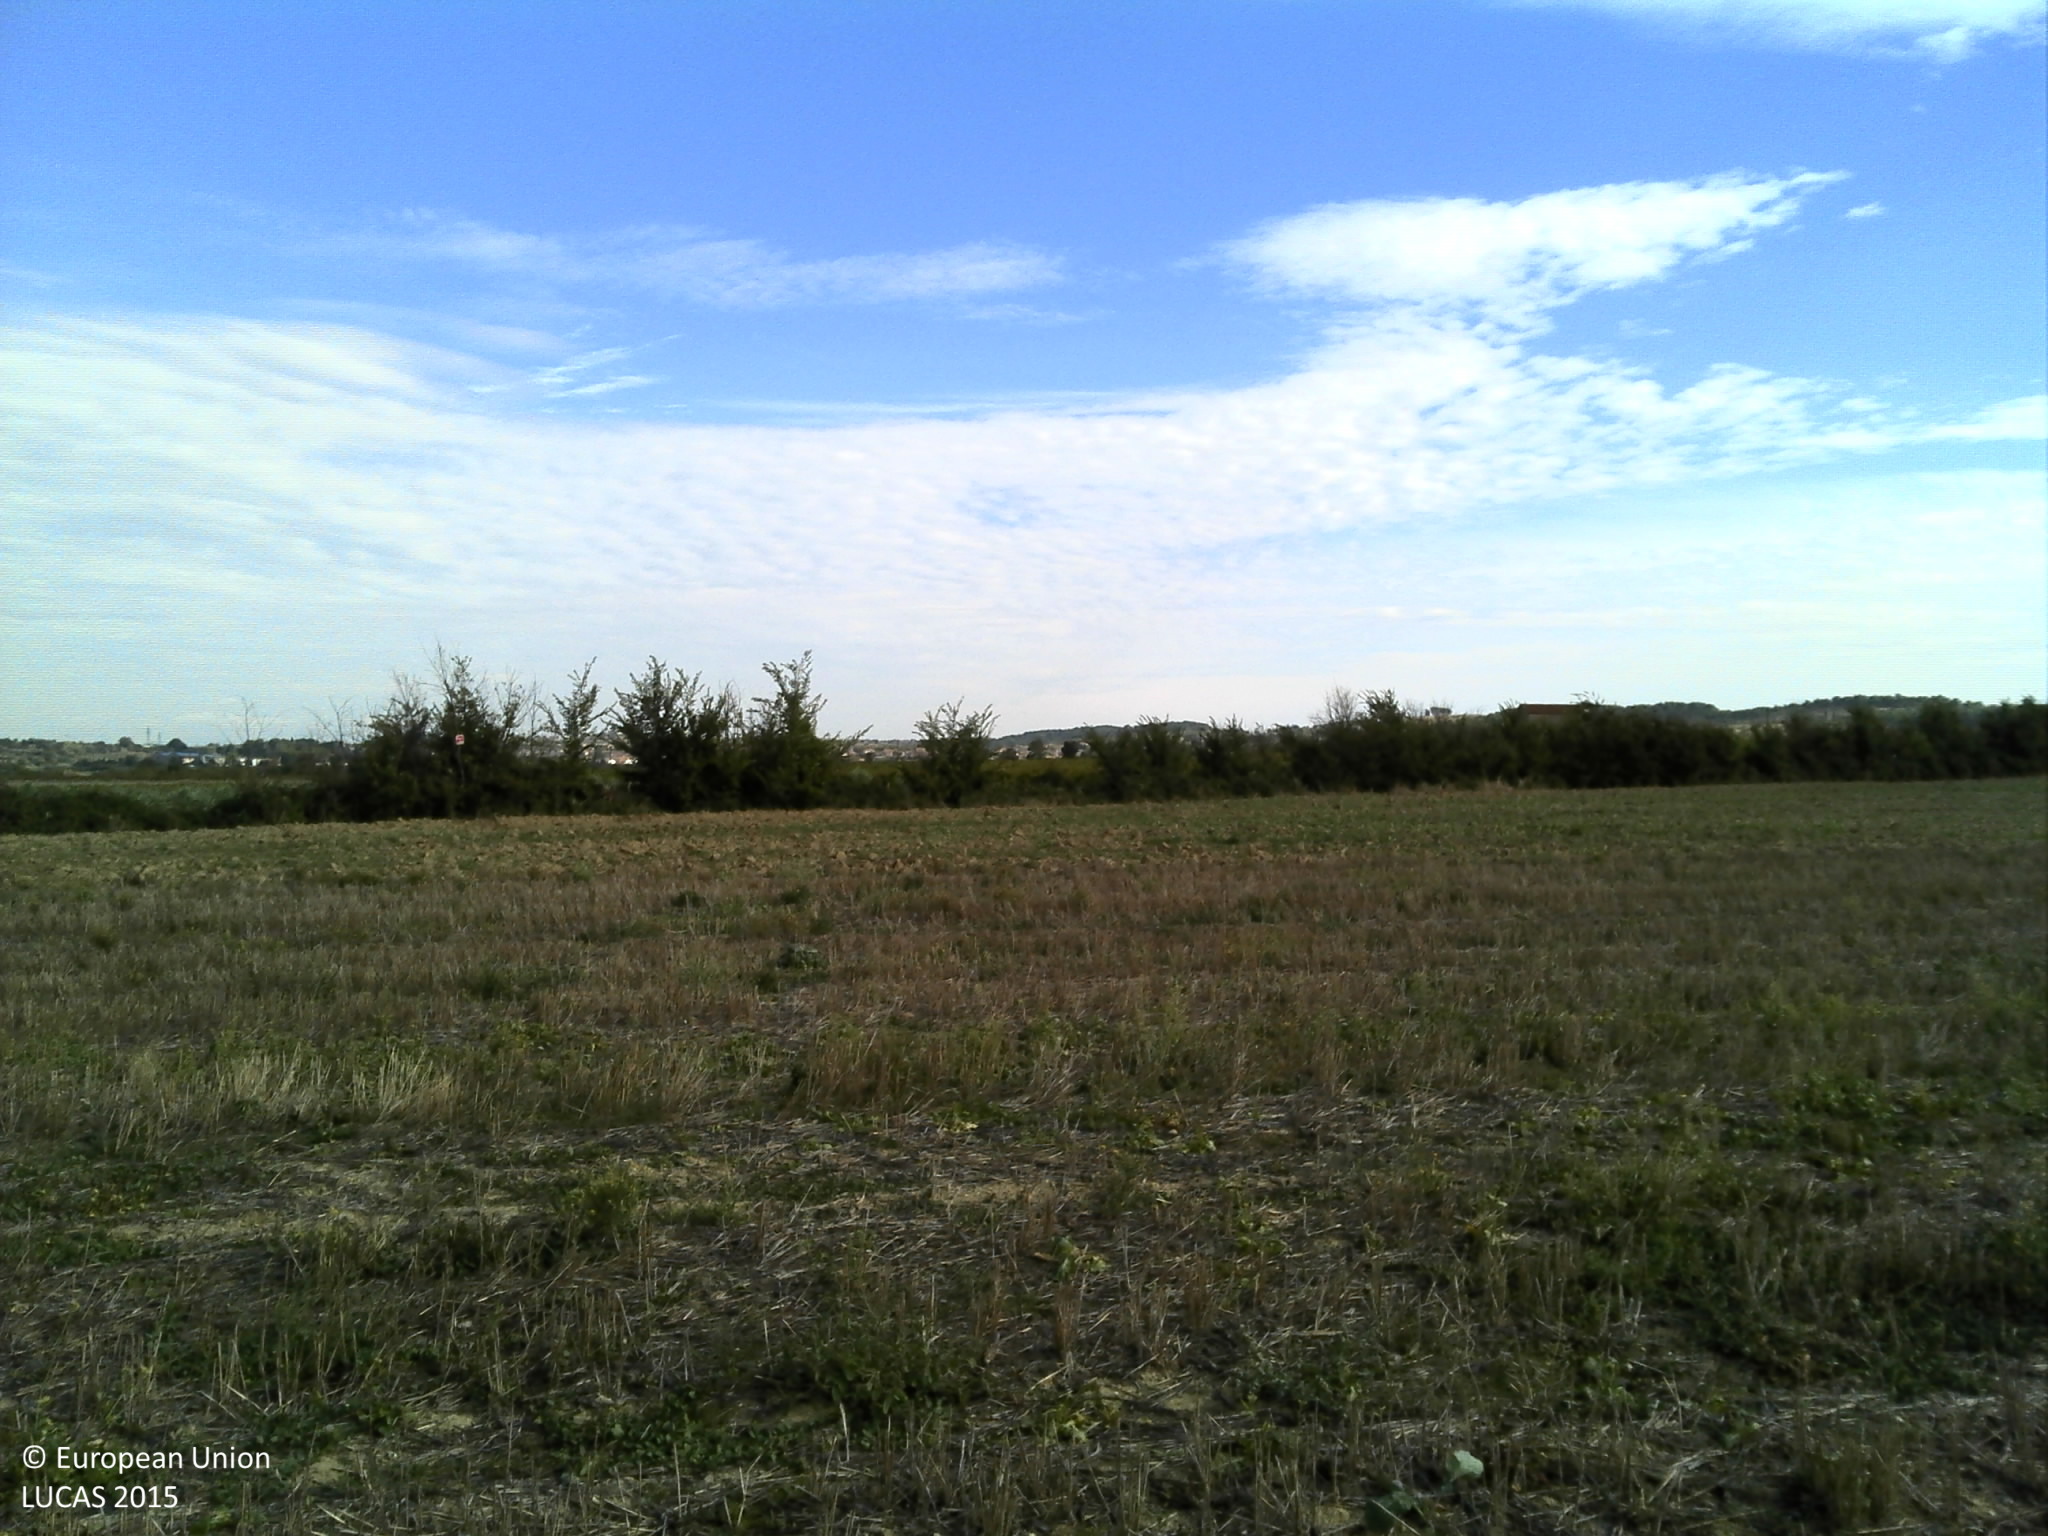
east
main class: Grassland
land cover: Spontaneously vegetated surfaces
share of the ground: 25 - 50 %
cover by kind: unconsolidated bare surface 70 %, herbaceous plants 30 %
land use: Agriculture (excluding fallow land and kitchen gardens)
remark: Harvested field
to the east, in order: Spontaneously vegetated surfaces; Abandoned hedges; Olive groves; Vineyards
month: October
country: FR
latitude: 43.2877
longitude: 3.0955
